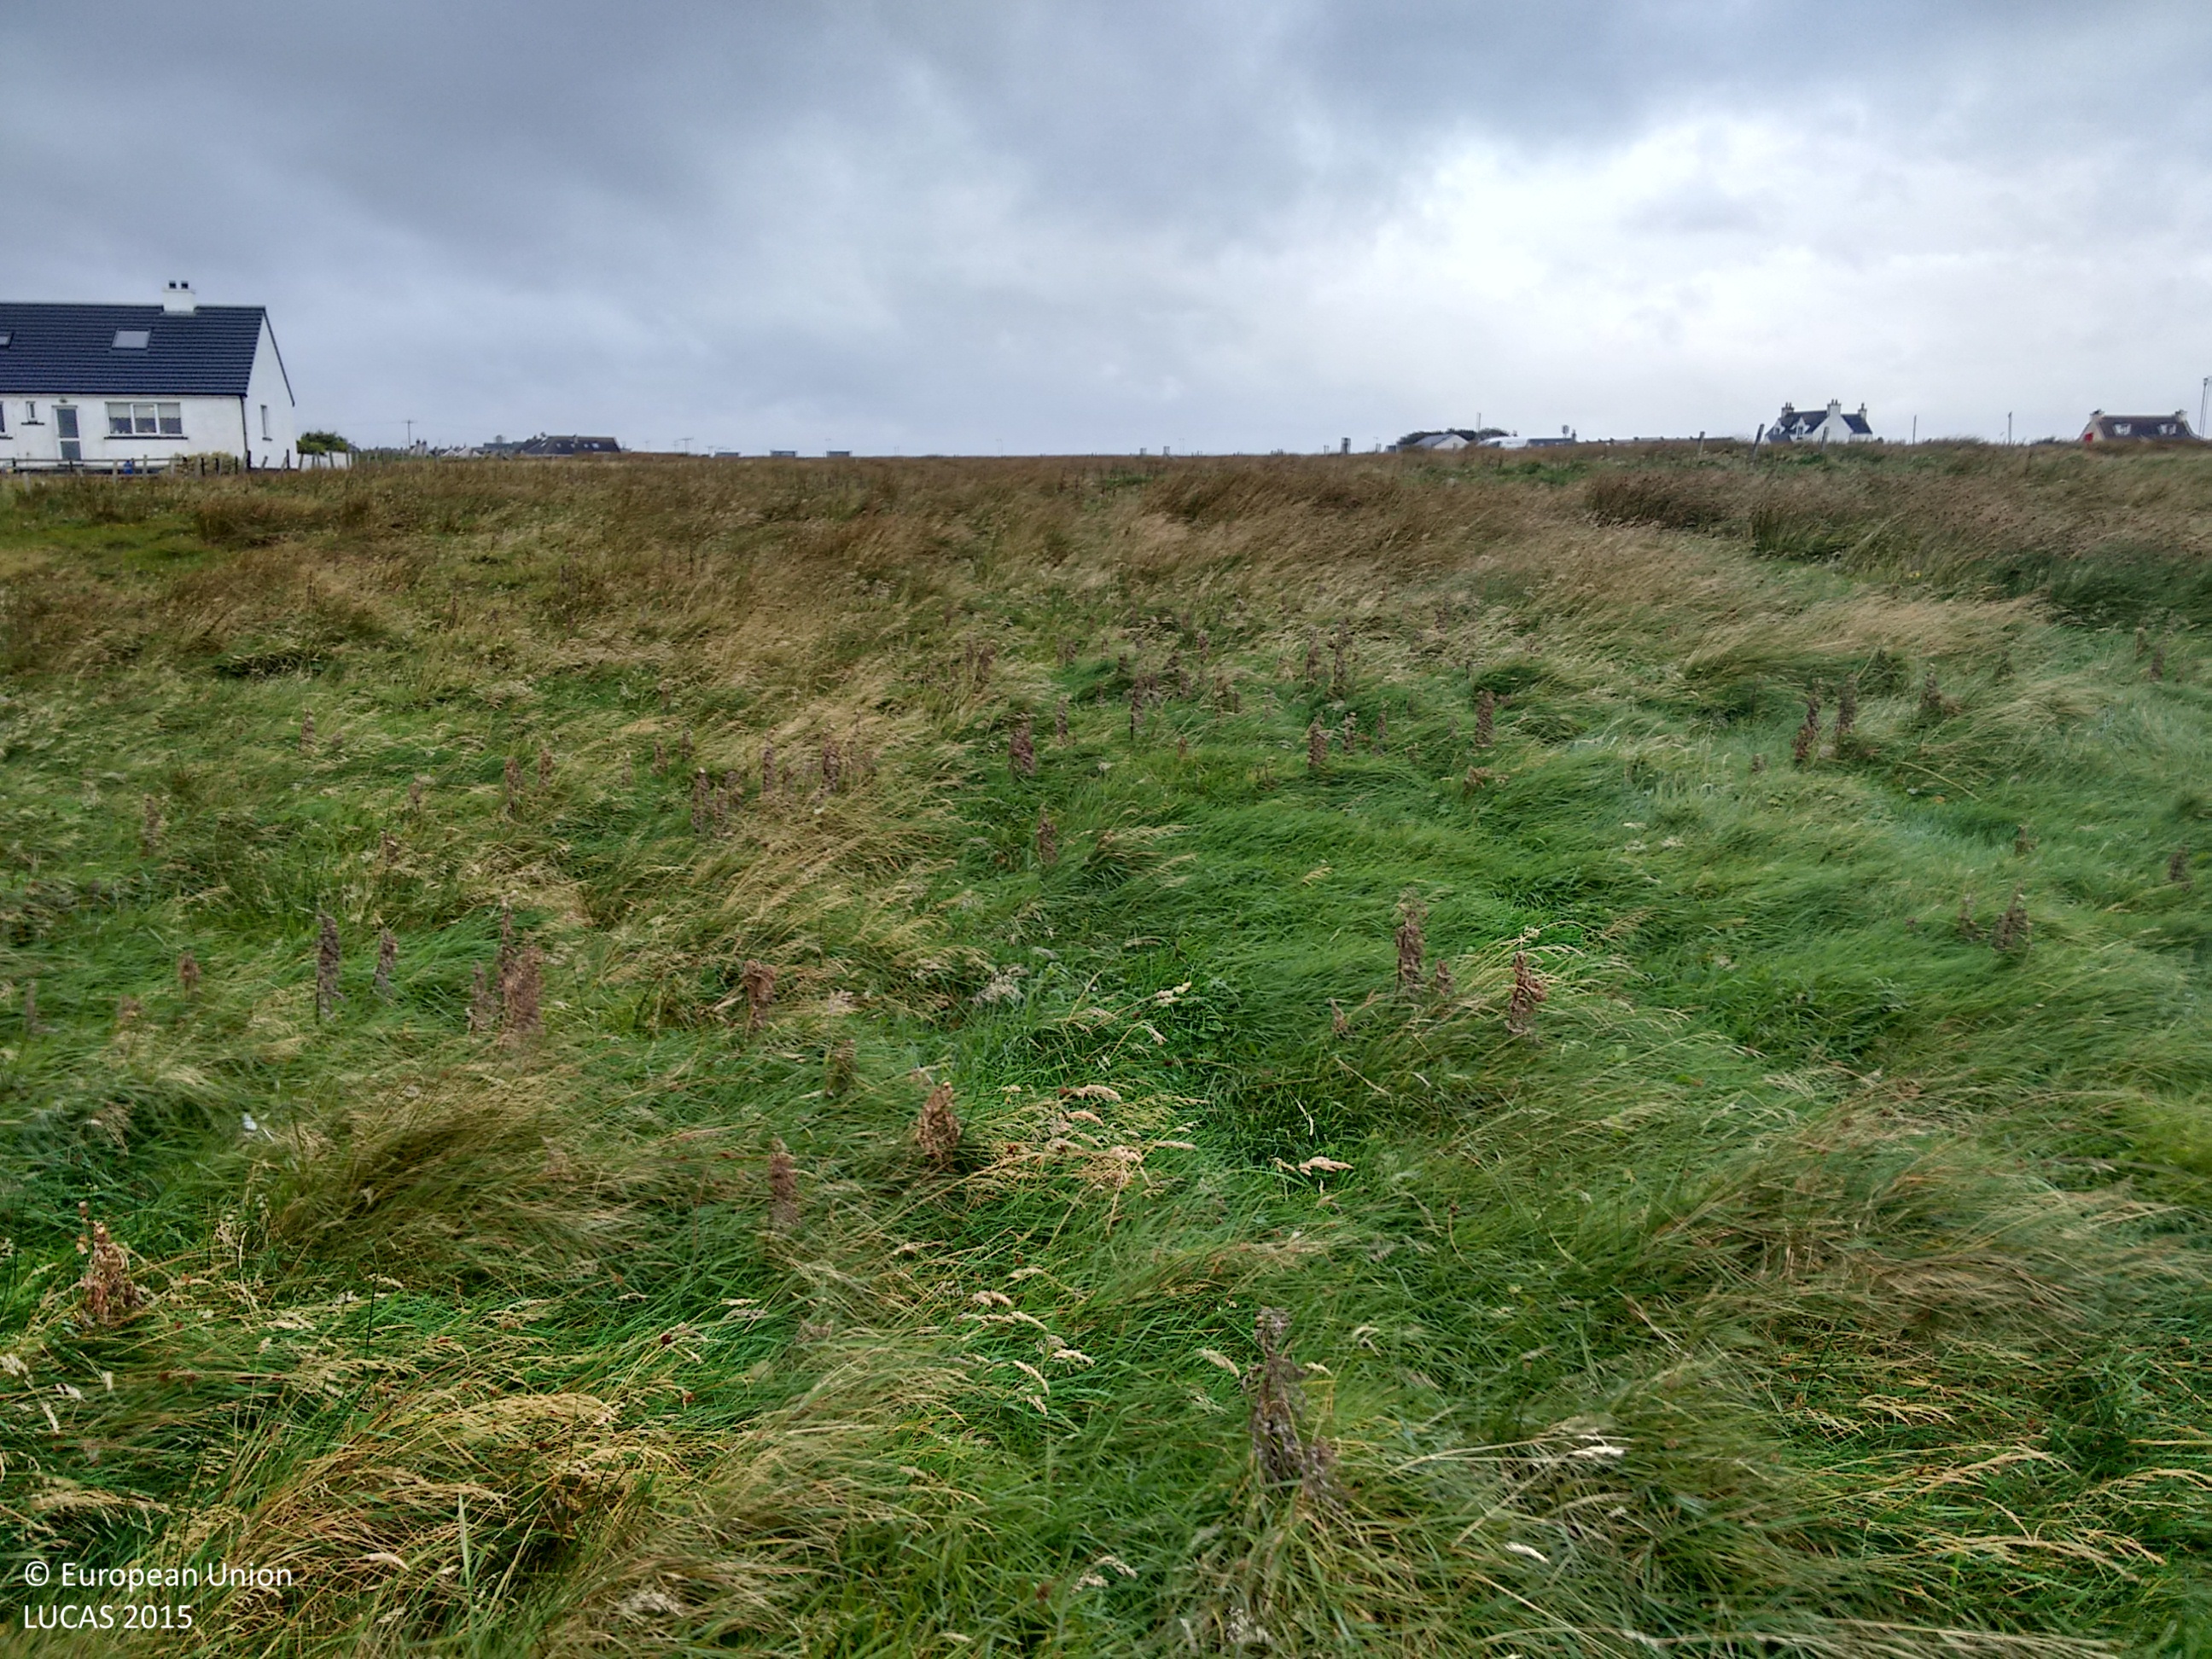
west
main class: Grassland
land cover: Grassland without tree/shrub cover
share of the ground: > 75 %
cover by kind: herbaceous plants 100 %
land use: Agriculture (excluding fallow land and kitchen gardens)
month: October
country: GB
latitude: 58.2442
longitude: -6.1585
